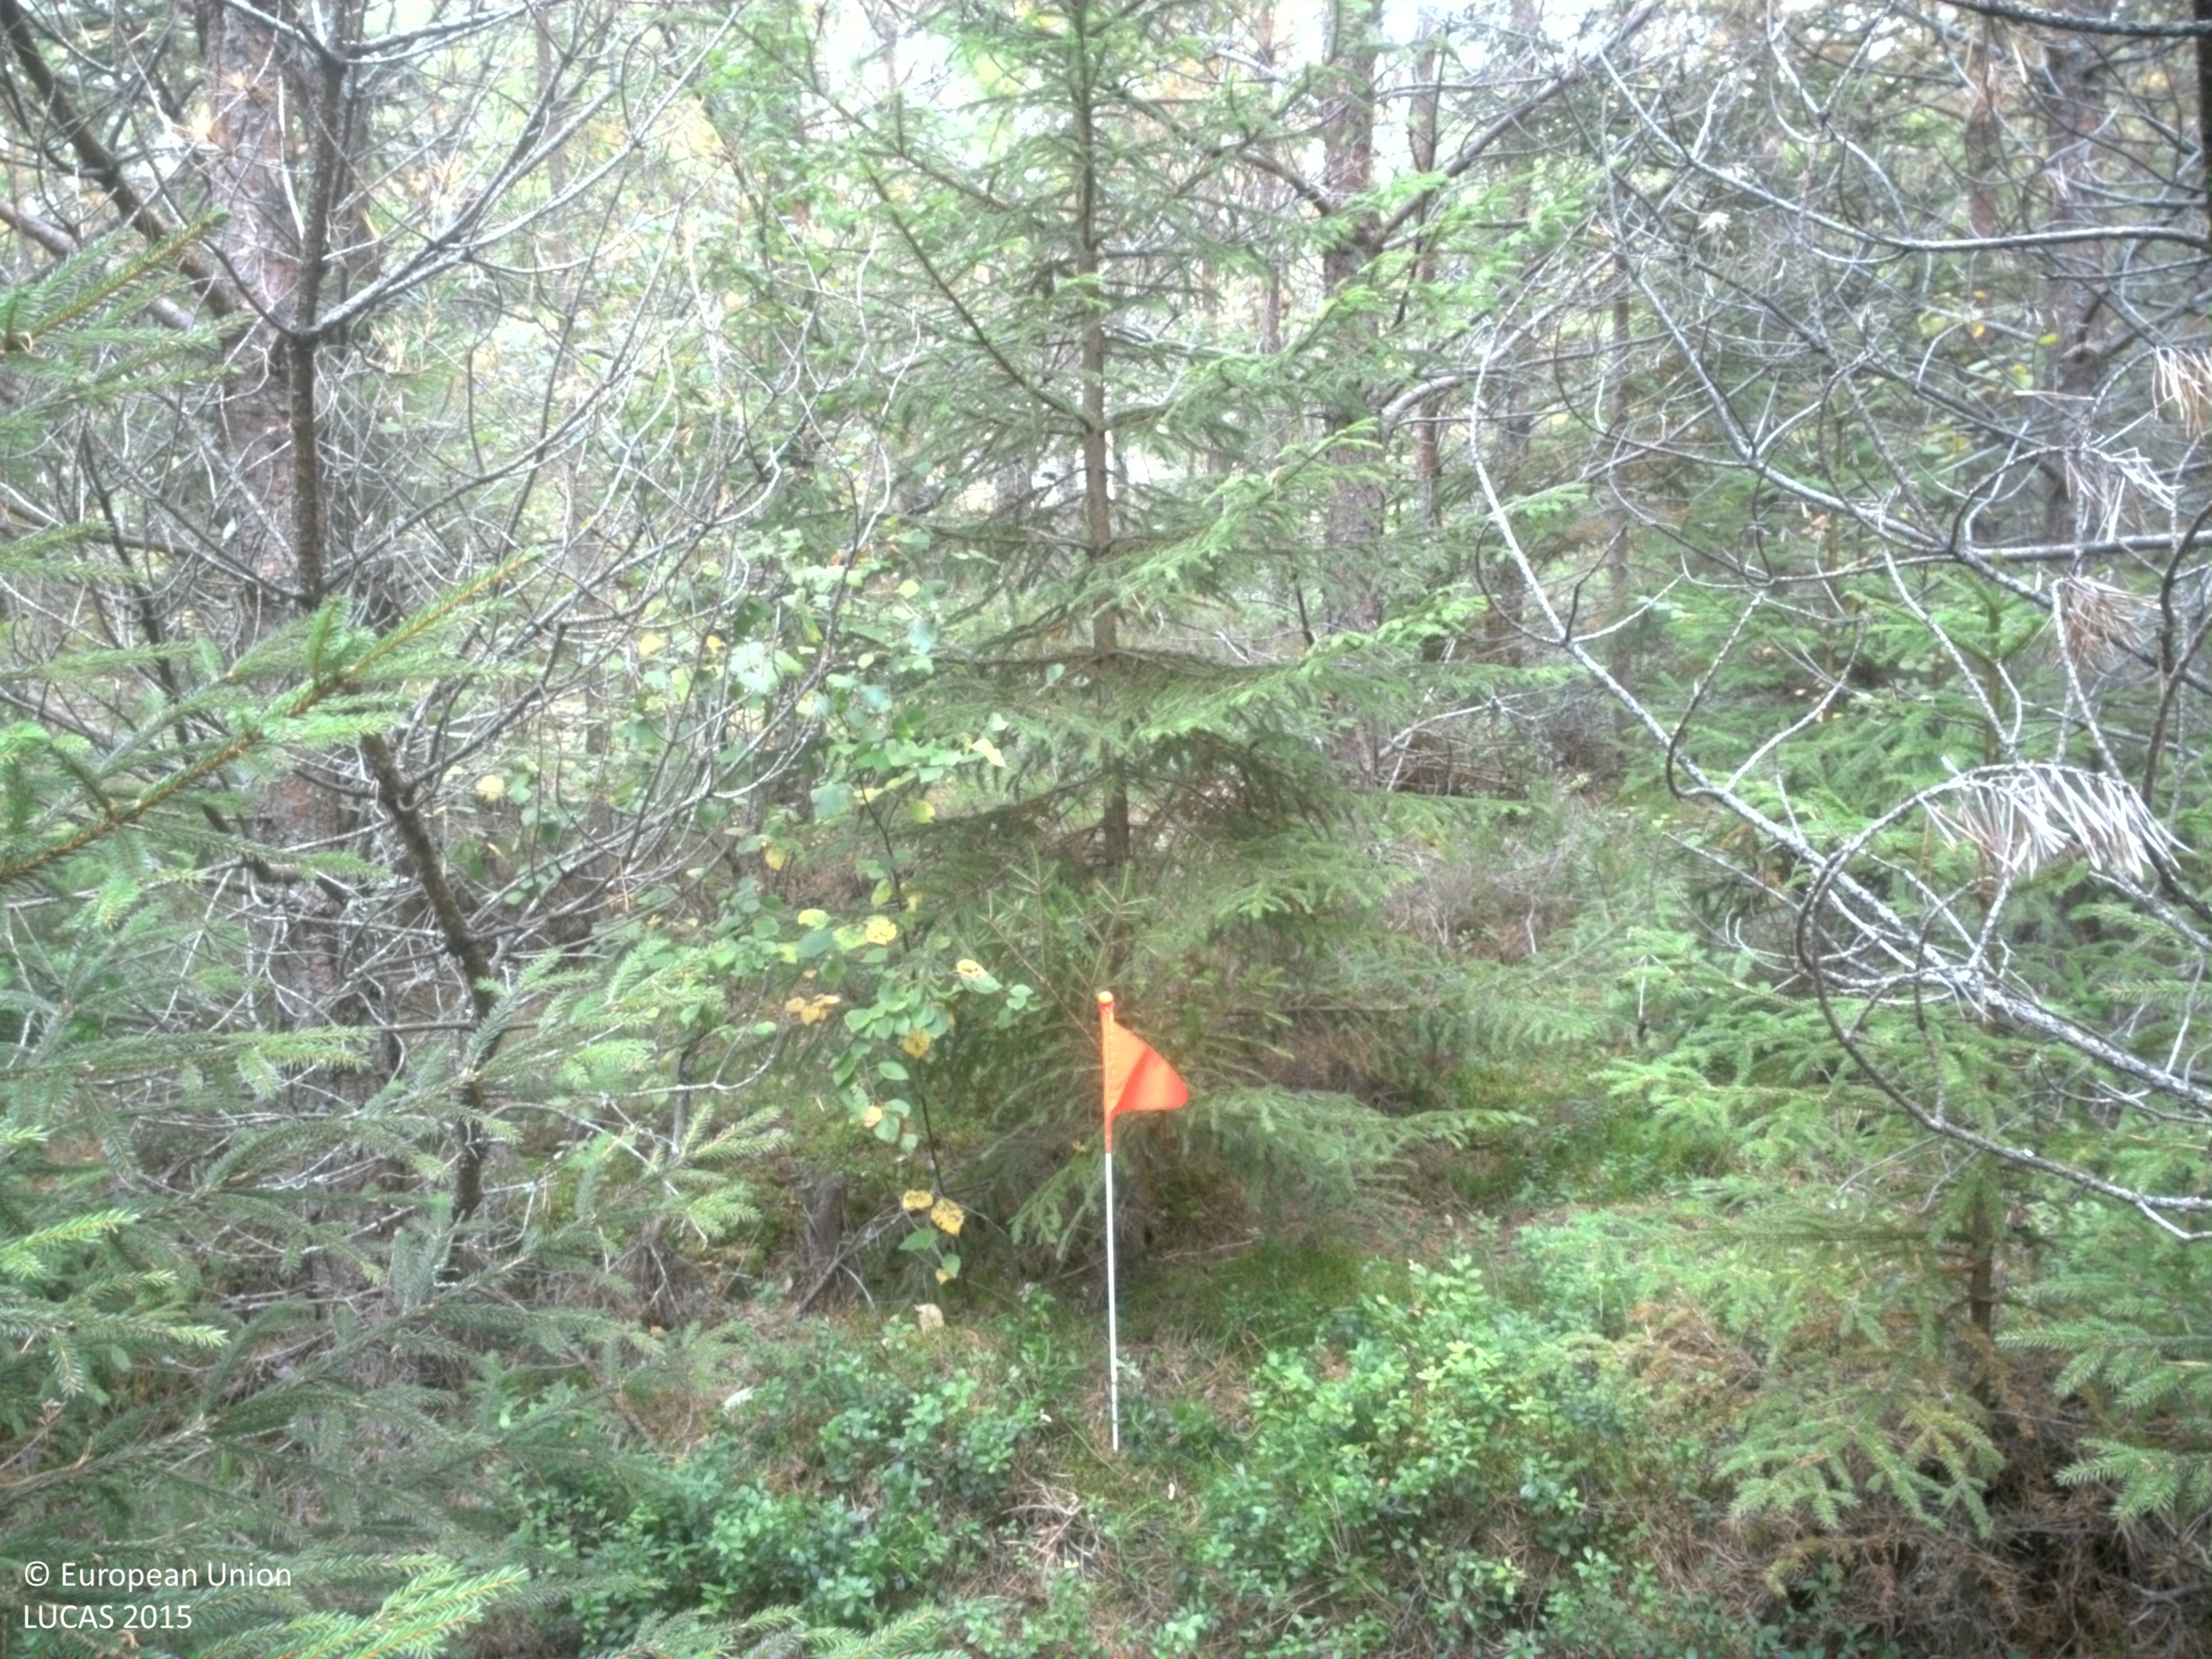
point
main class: Woodland
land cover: Pine dominated coniferous woodland
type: boreal forest
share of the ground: > 75 %
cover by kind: coniferous forest trees 80 %, shrubs 10 %, lichens and mosses 10 %
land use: Forestry
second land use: Amenities, museums, leisure
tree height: > 5 m
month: September
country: SE
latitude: 59.7269
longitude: 15.5923
